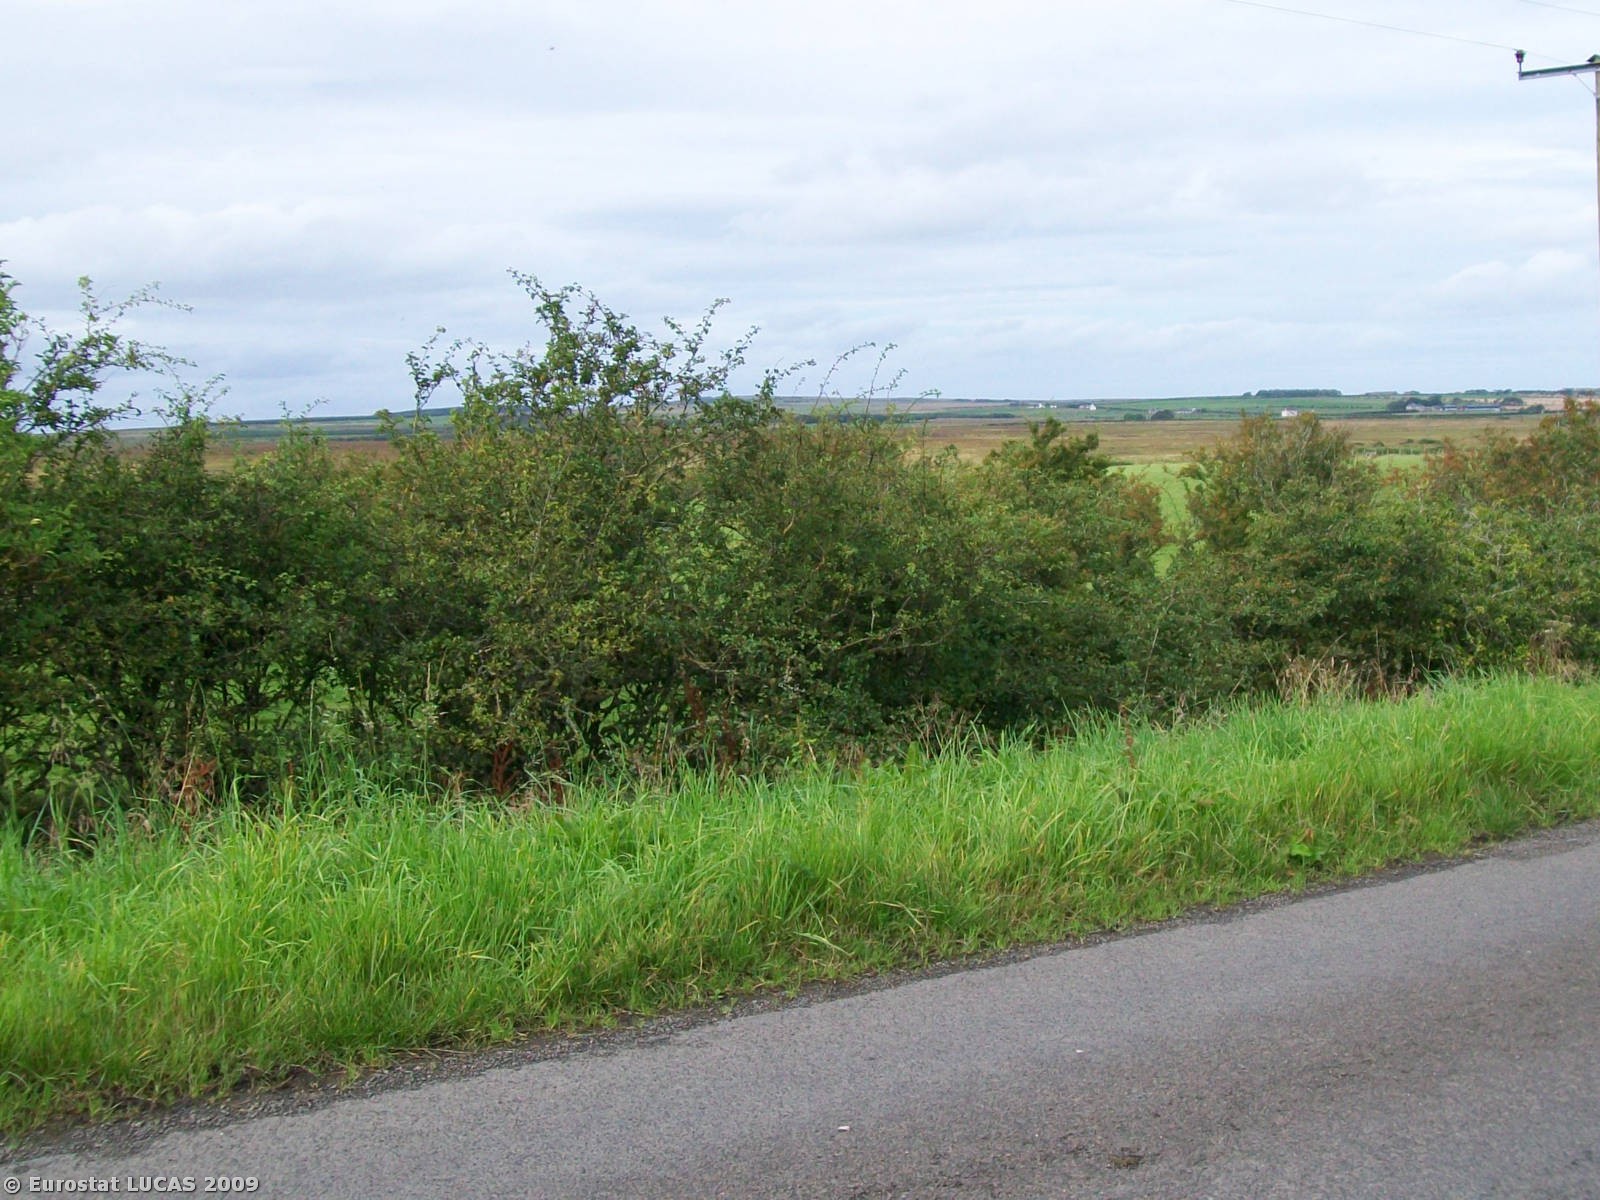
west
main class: Grassland
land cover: Grassland without tree/shrub cover
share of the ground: > 75 %
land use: Agriculture (excluding fallow land and kitchen gardens)
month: August
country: GB
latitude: 58.4526
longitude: -3.2727
